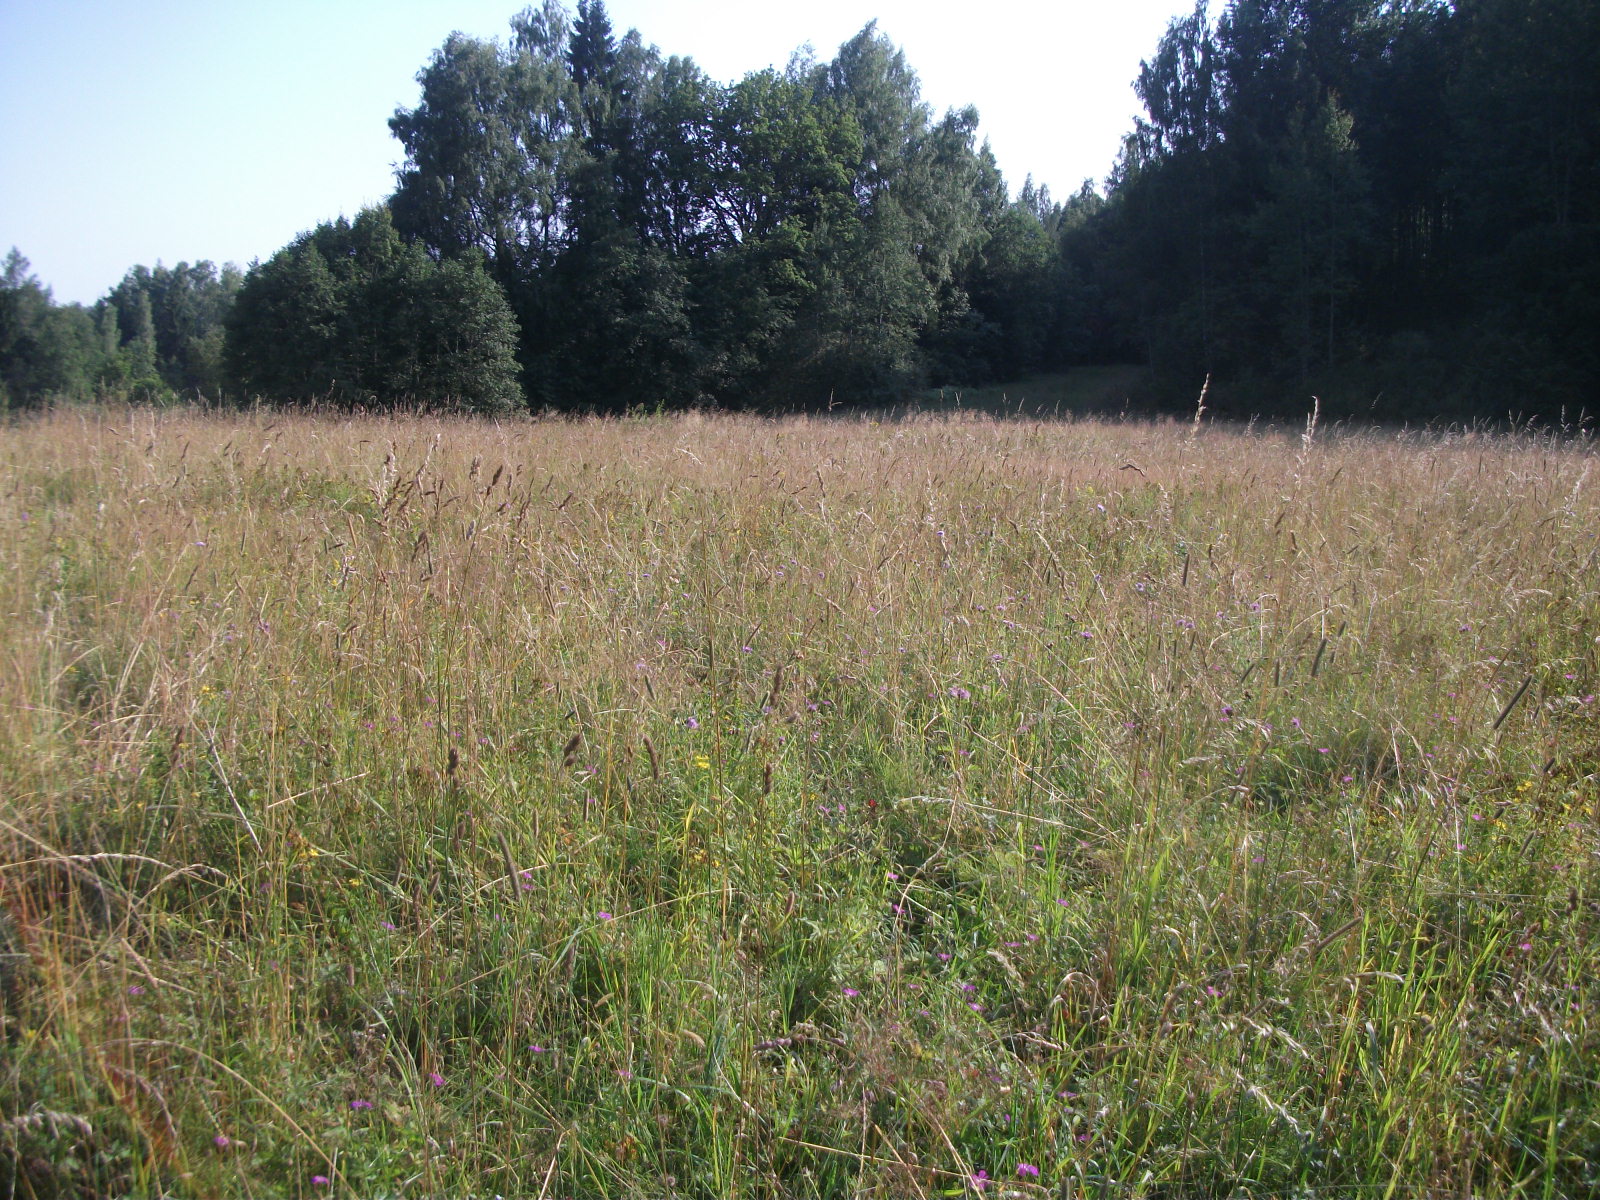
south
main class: Grassland
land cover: Grassland without tree/shrub cover
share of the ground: > 75 %
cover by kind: herbaceous plants 100 %
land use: Agriculture (excluding fallow land and kitchen gardens)
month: August
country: LV
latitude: 56.7926
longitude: 25.6933
